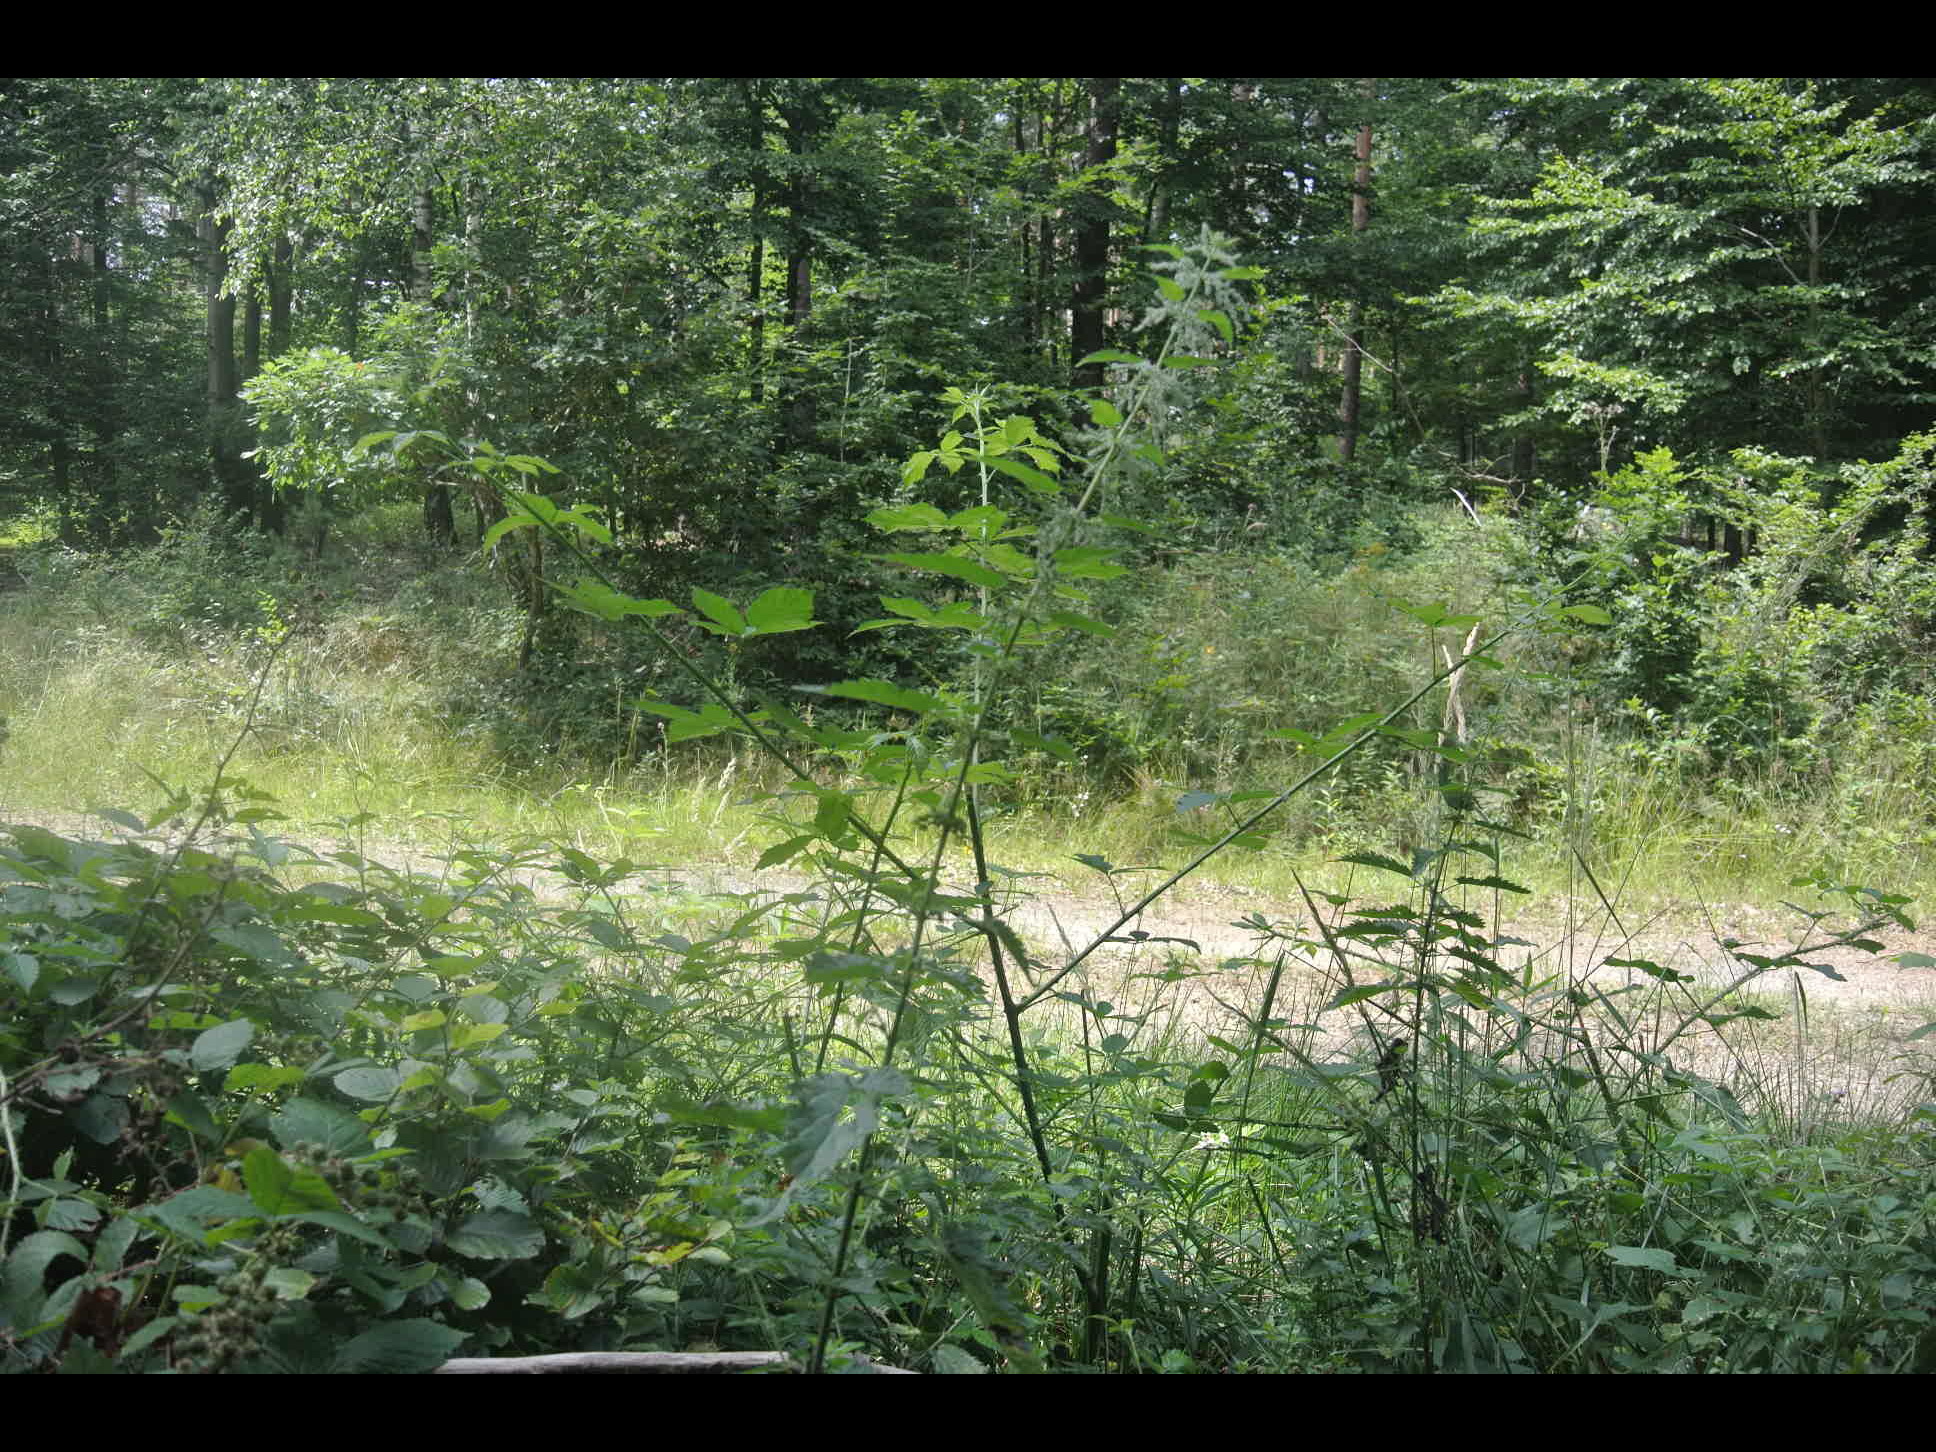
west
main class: Woodland
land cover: Spruce dominated mixed woodland
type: alpine coniferous forest
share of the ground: > 75 %
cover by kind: broadleaved forest trees 70 %, coniferous forest trees 30 %
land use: Forestry
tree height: > 5 m
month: July
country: AT
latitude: 47.4218
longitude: 16.4323
